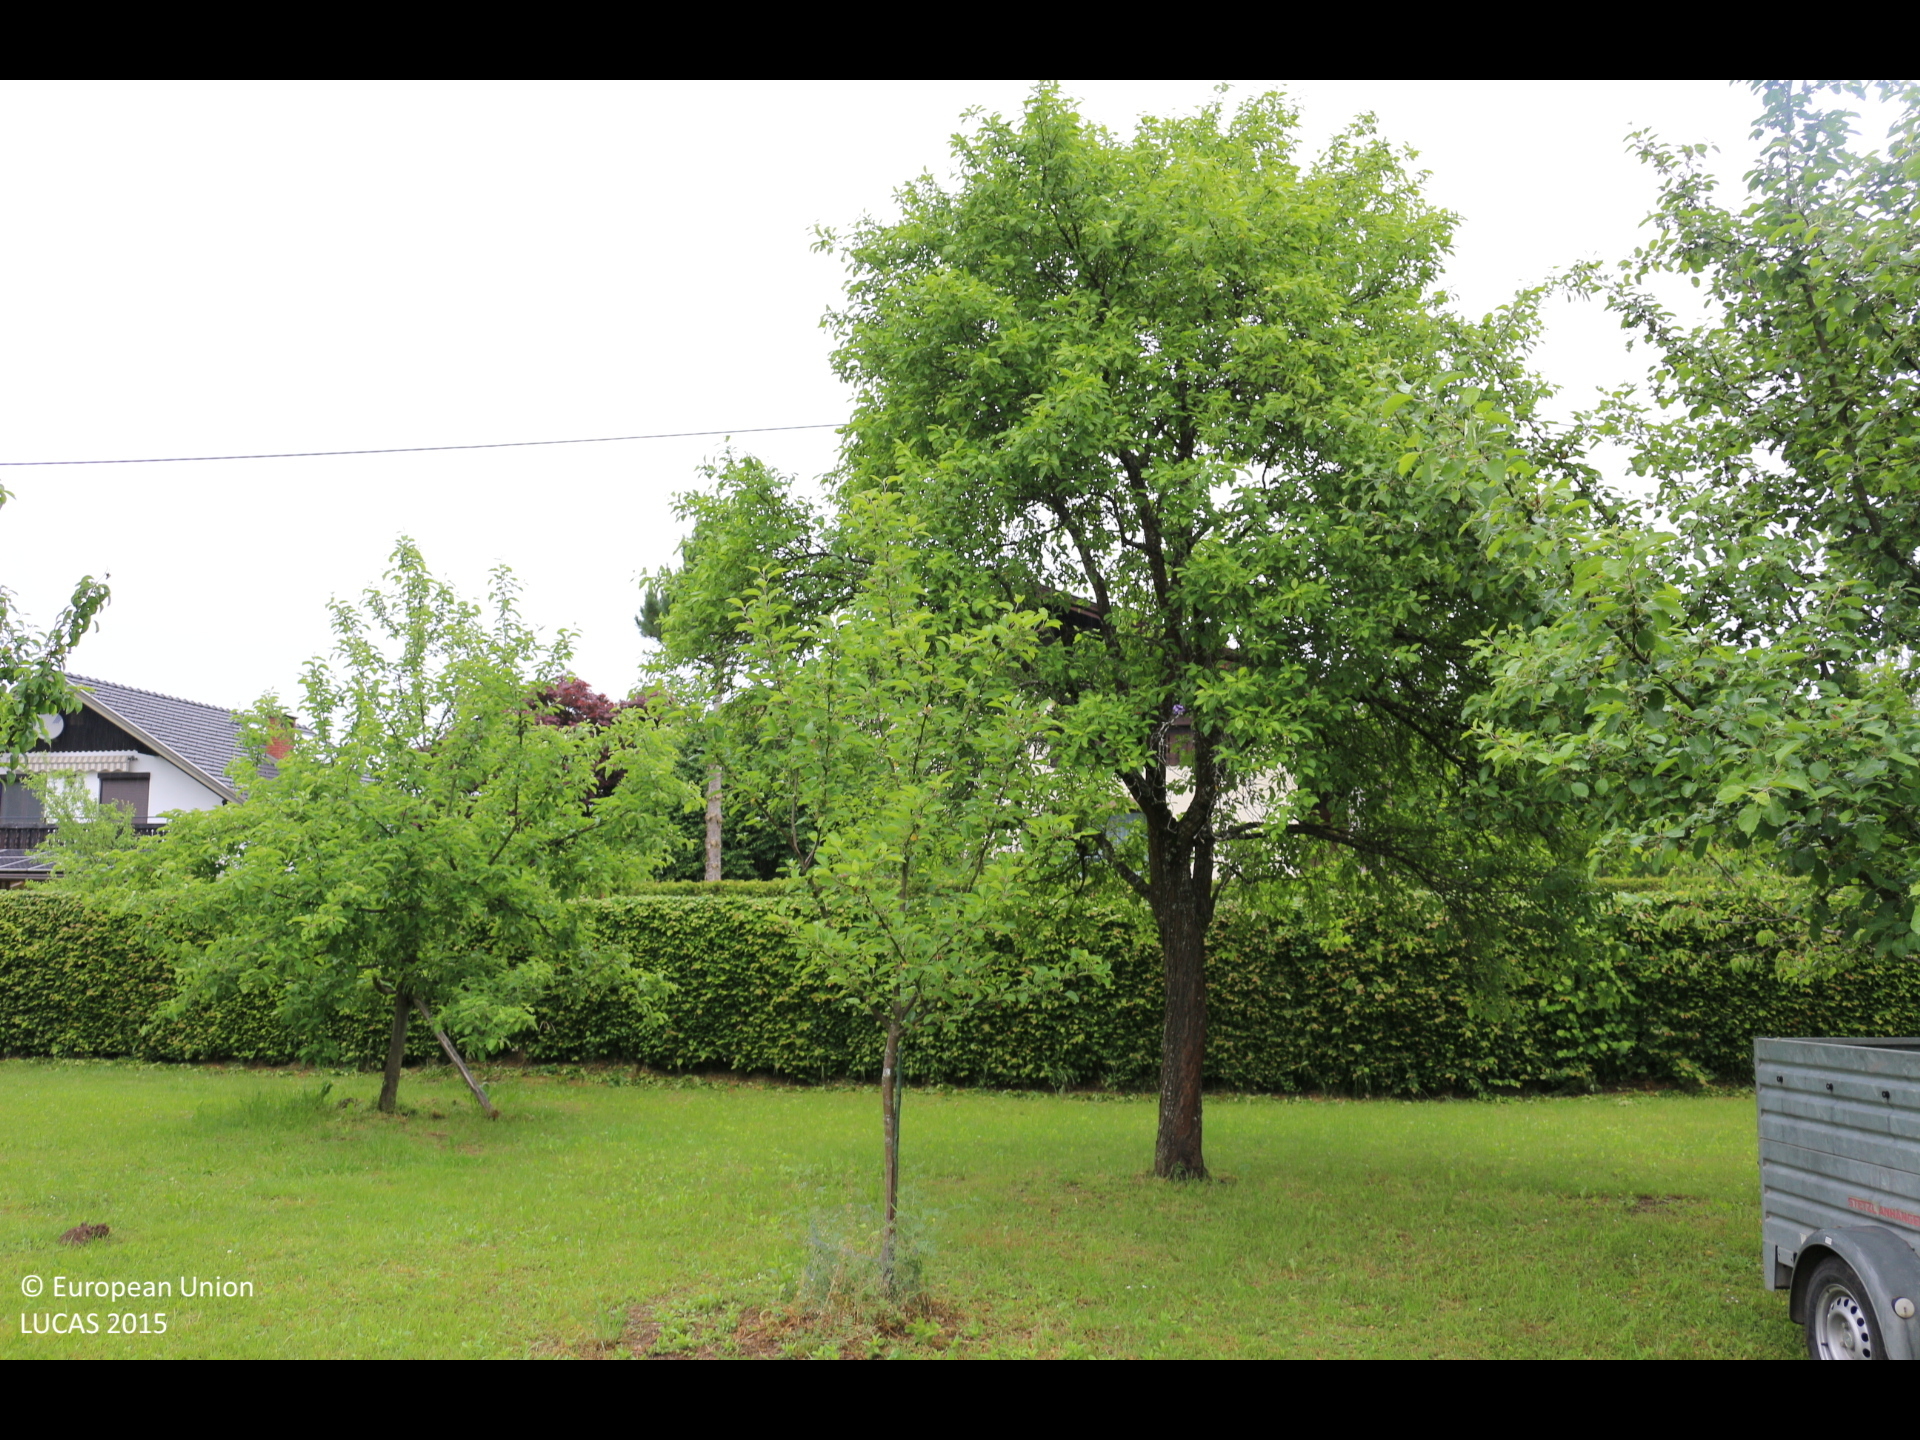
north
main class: Grassland
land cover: Grassland with sparse tree/shrub cover
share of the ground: > 75 %
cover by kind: herbaceous plants 90 %, broadleaved forest trees 5 %, shrubs 5 %
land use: Residential
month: May
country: AT
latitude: 46.6858
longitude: 14.1422
